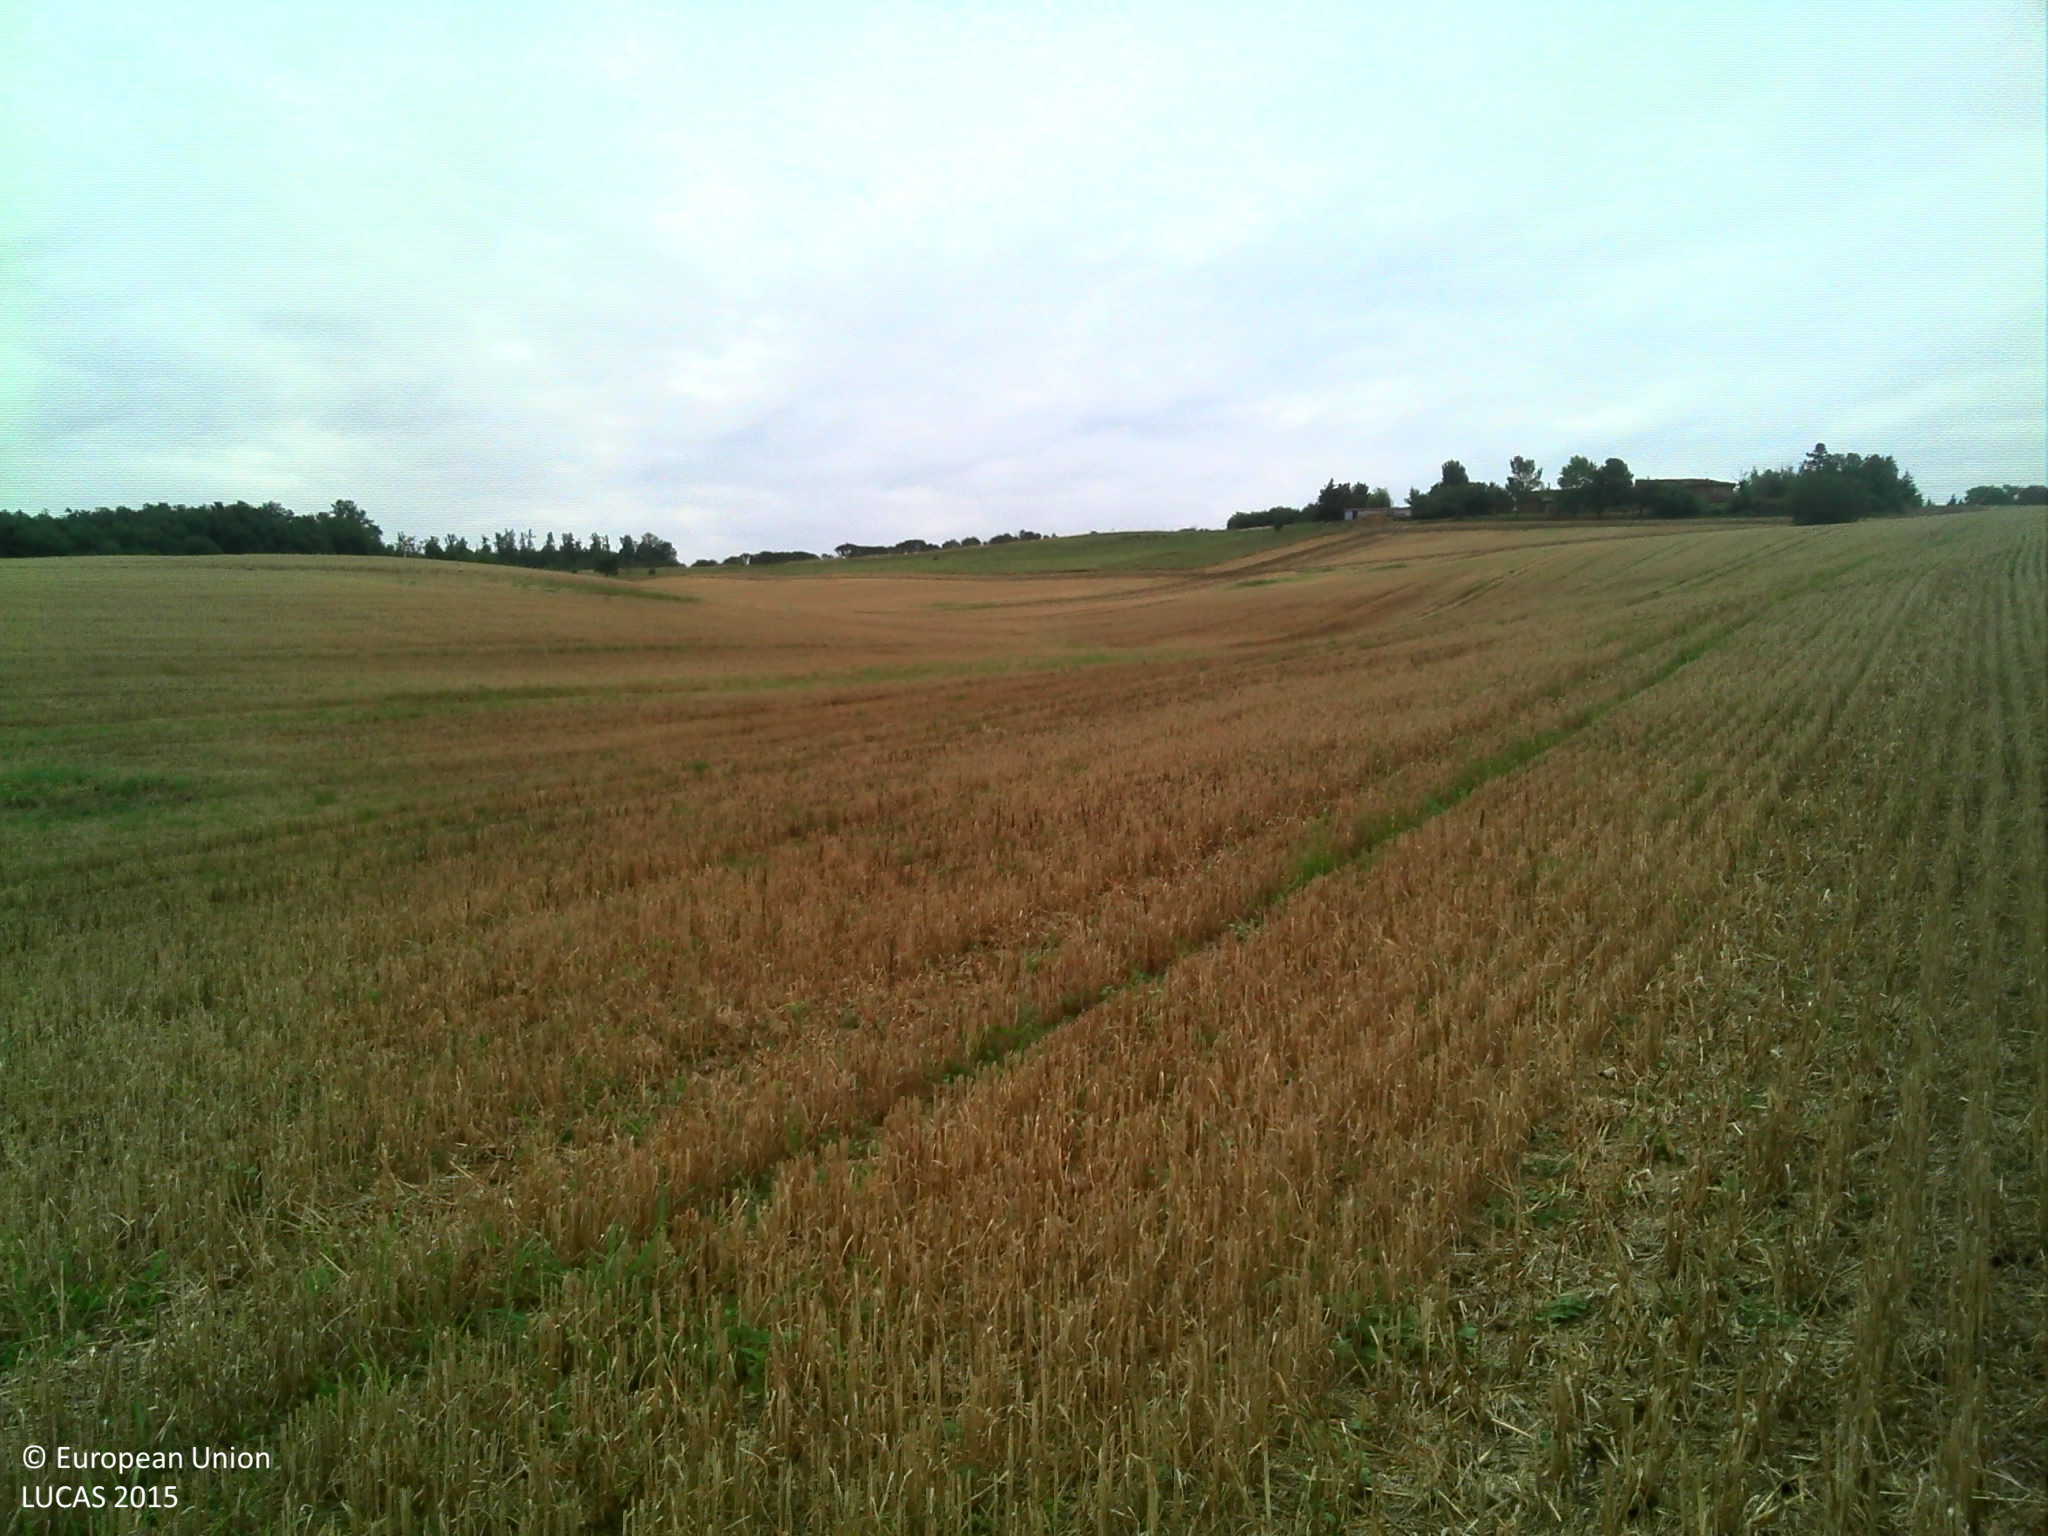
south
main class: Cropland
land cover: Common wheat
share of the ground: > 75 %
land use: Agriculture (excluding fallow land and kitchen gardens)
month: August
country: FR
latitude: 43.3749
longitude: 1.5996
